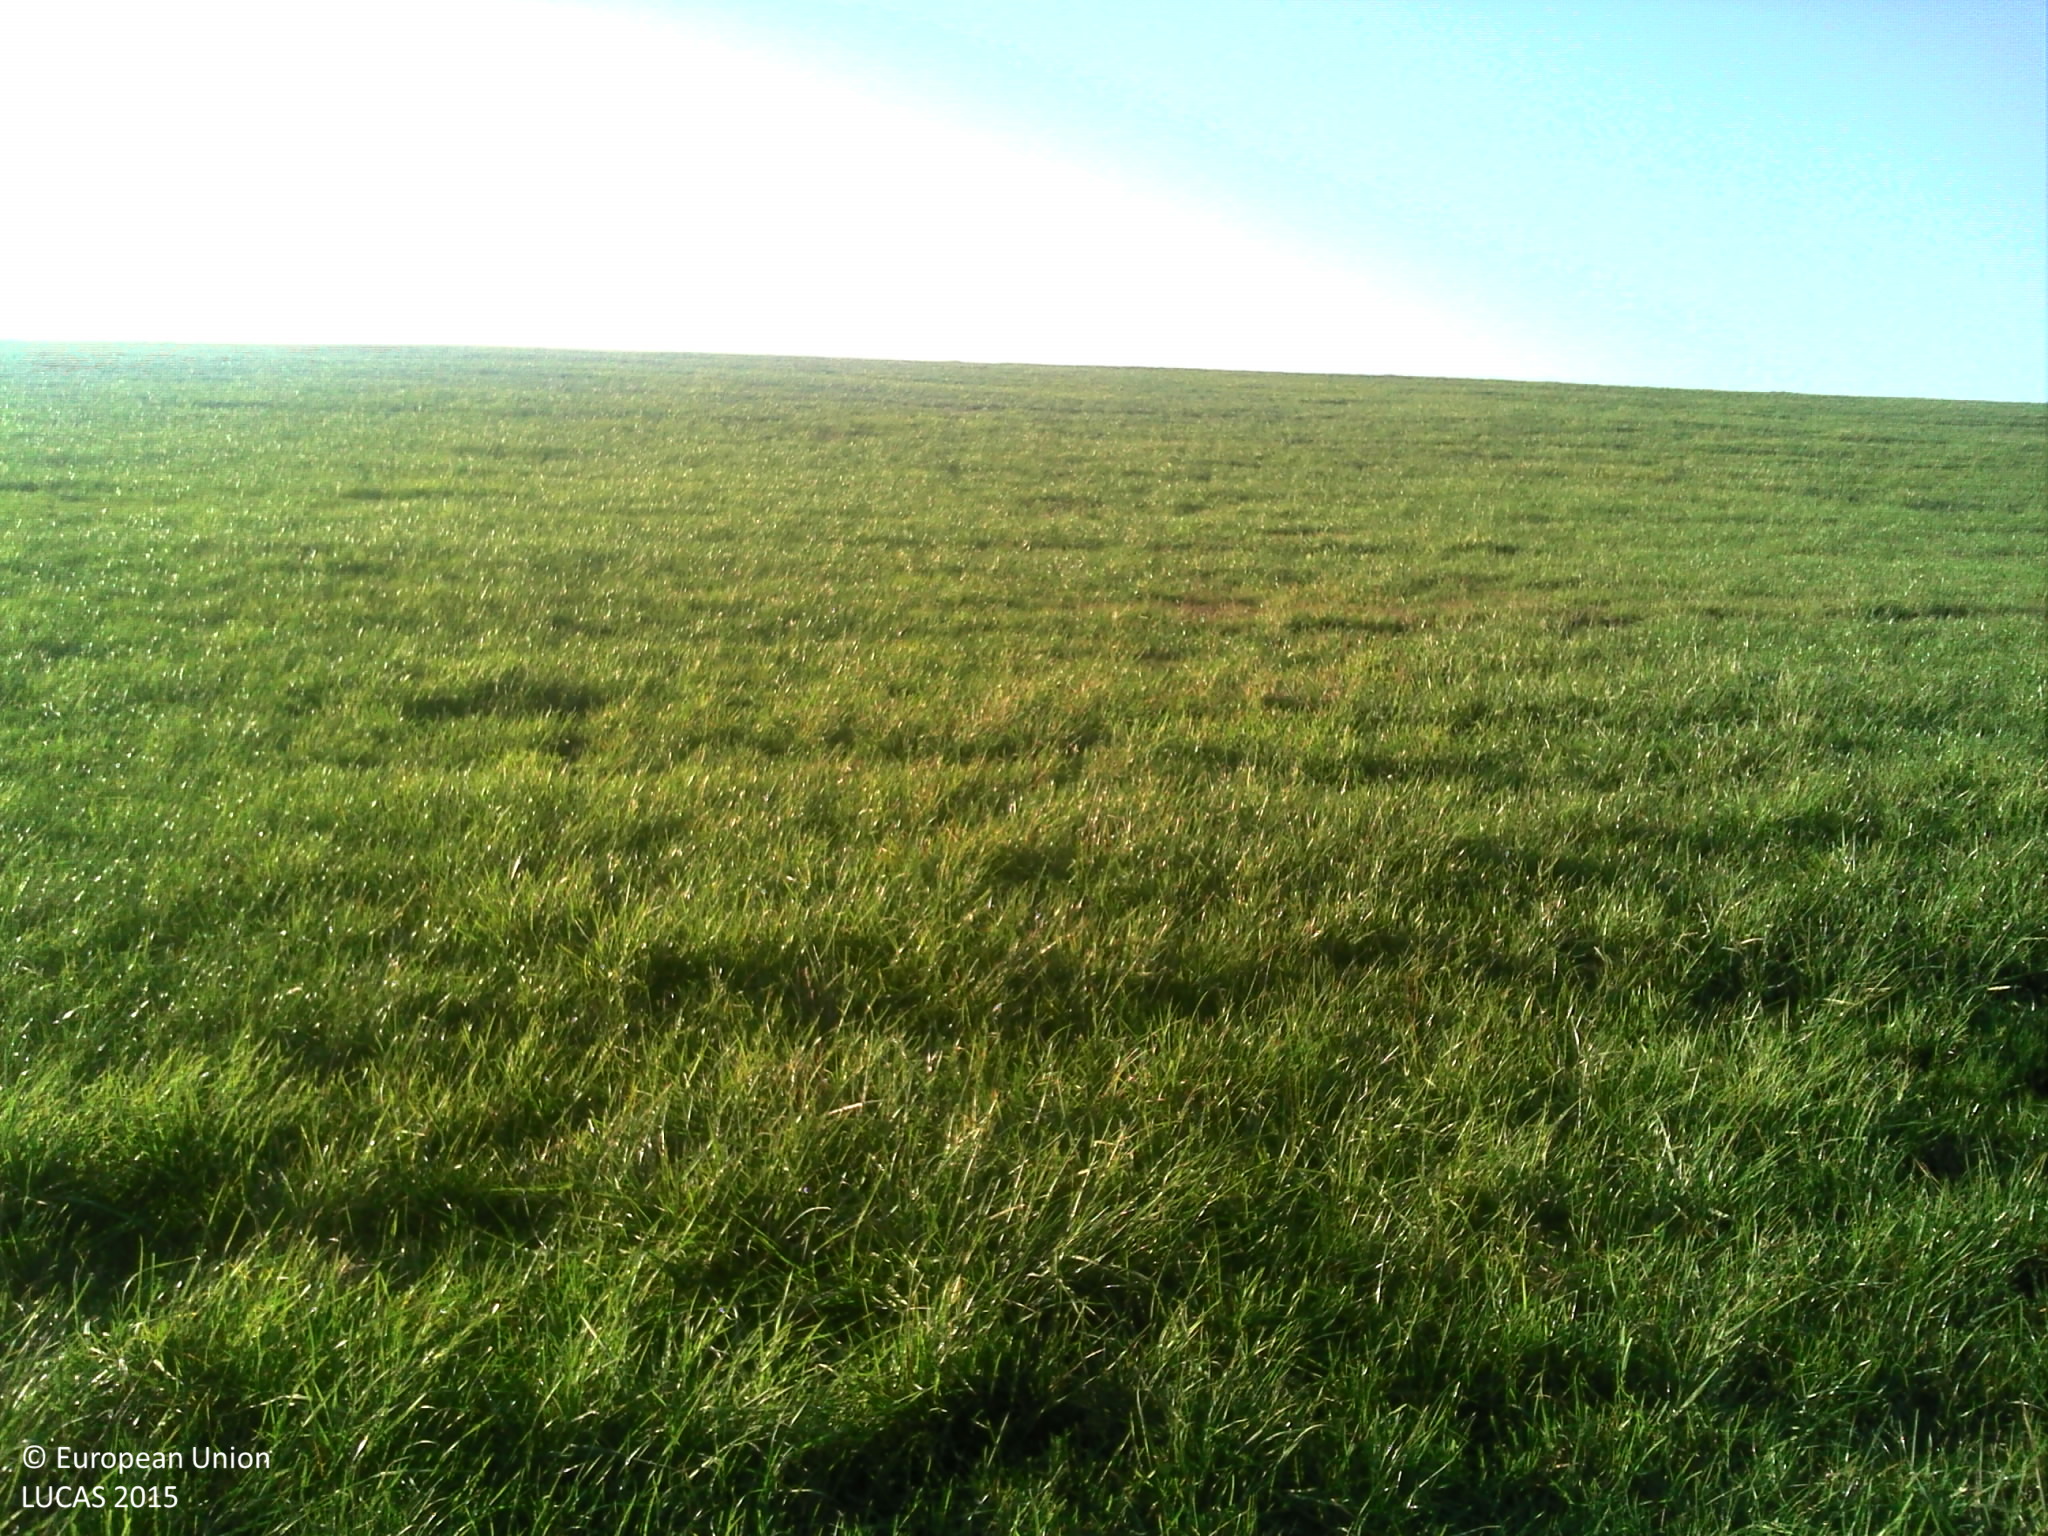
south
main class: Grassland
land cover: Grassland without tree/shrub cover
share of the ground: > 75 %
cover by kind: herbaceous plants 95 %, consolidated bare surface 5 %
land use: Agriculture (excluding fallow land and kitchen gardens)
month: October
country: FR
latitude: 48.4671
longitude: 6.2809
